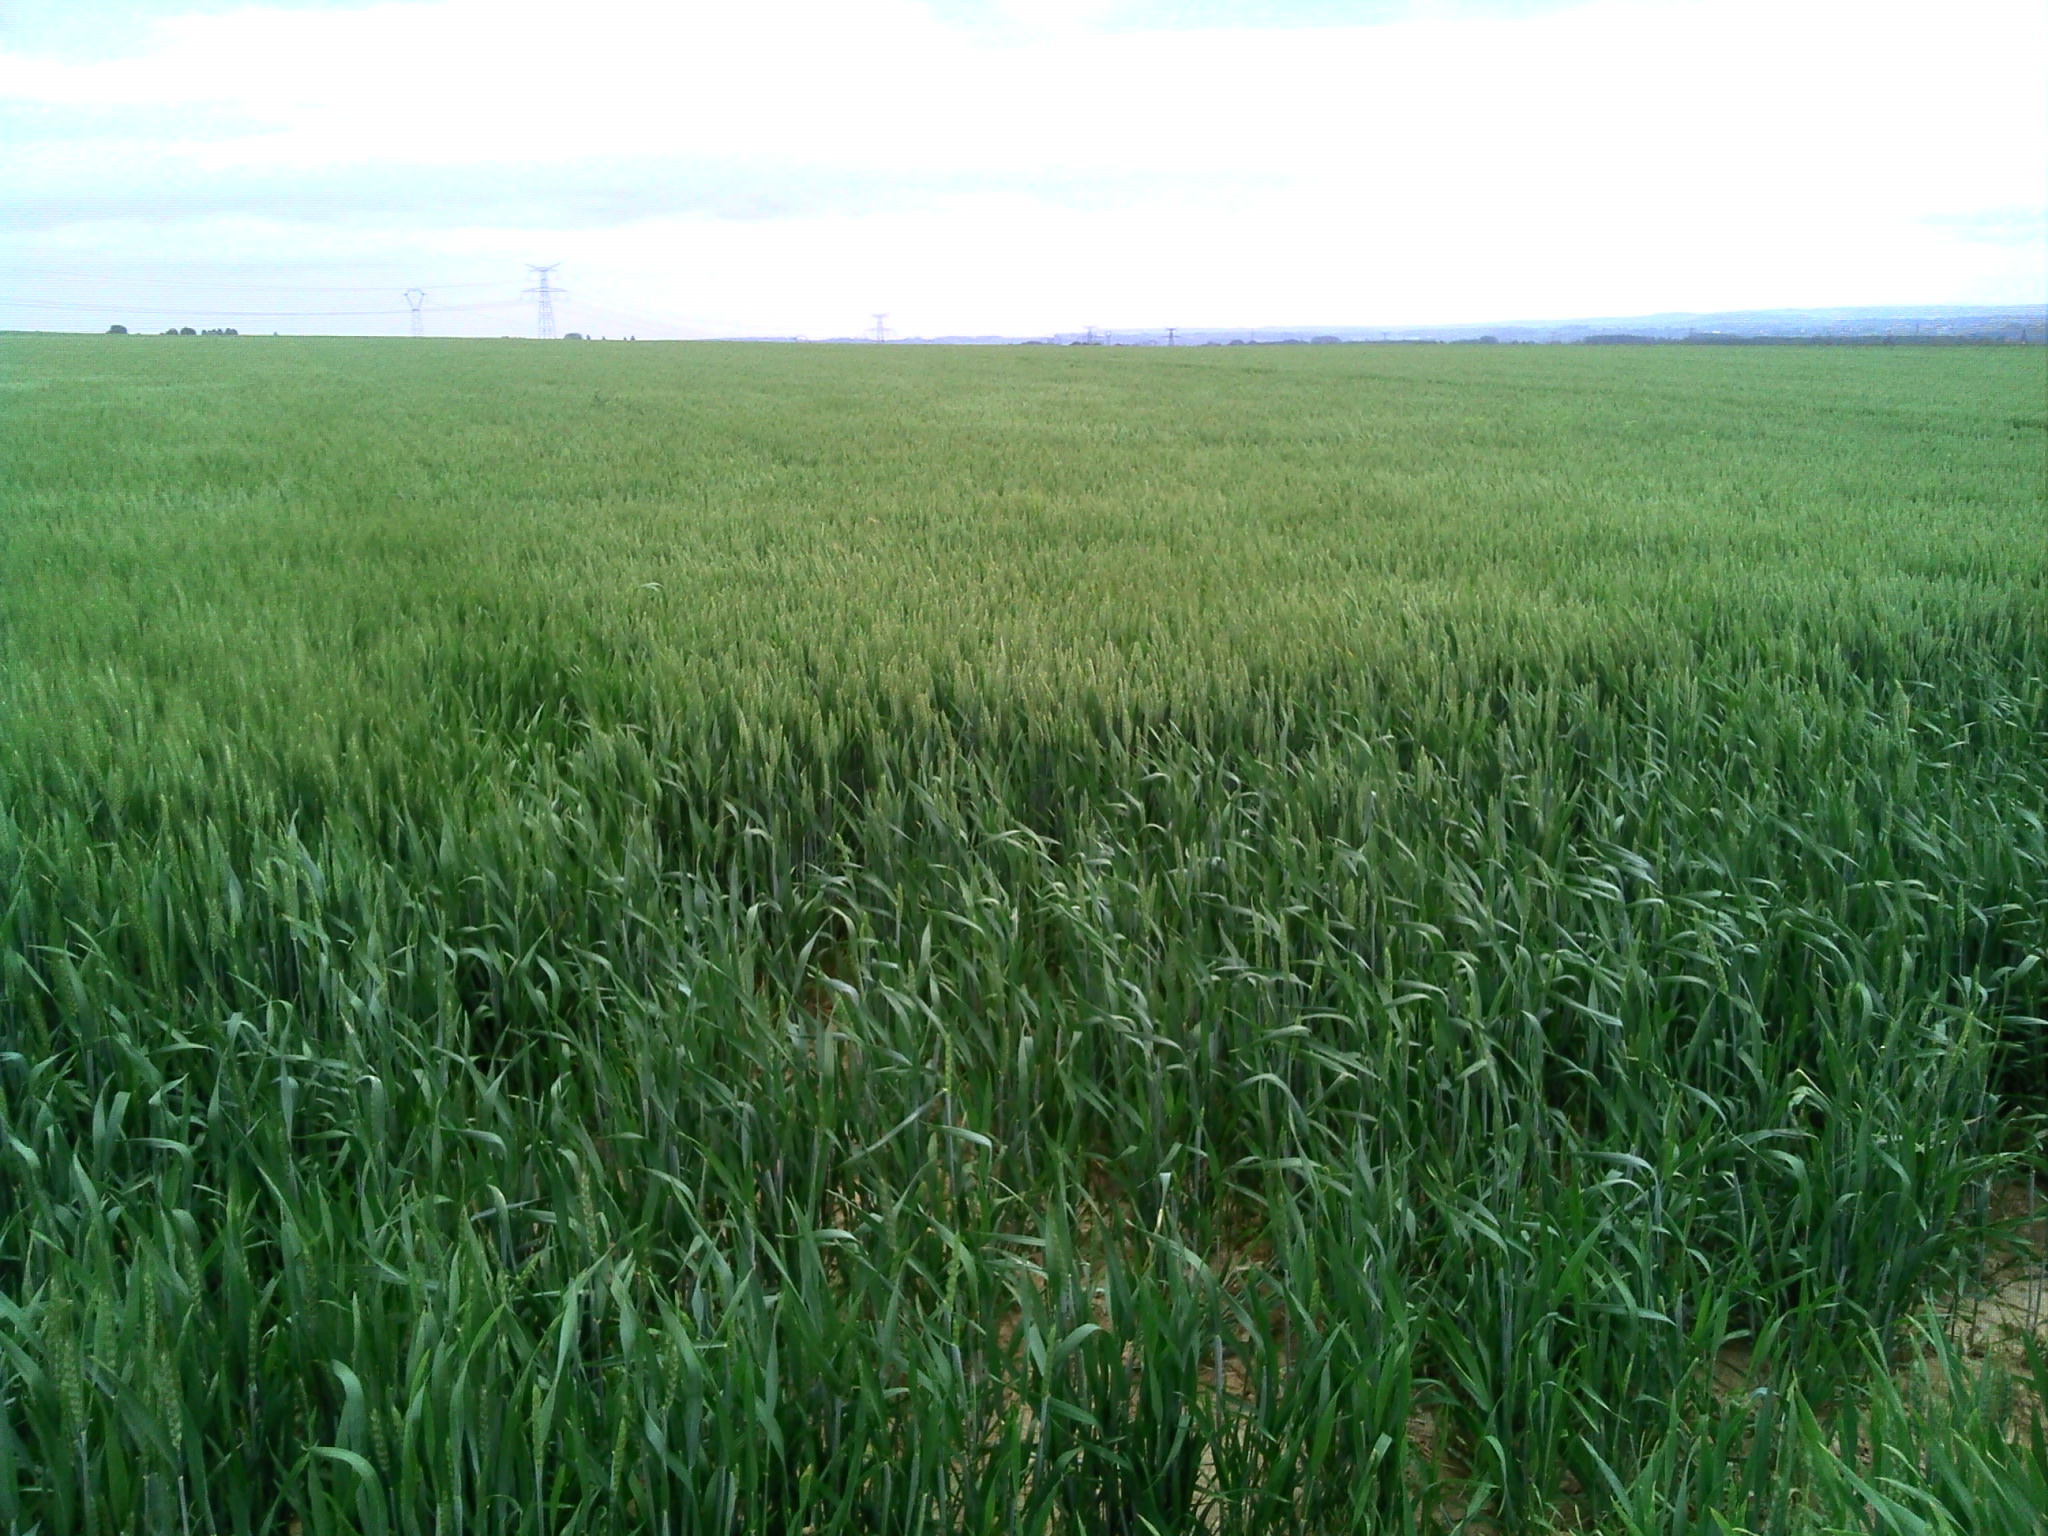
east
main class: Cropland
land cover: Common wheat
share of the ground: > 75 %
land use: Agriculture (excluding fallow land and kitchen gardens)
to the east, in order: Common wheat
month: June
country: FR
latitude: 49.6395
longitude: 3.2201
